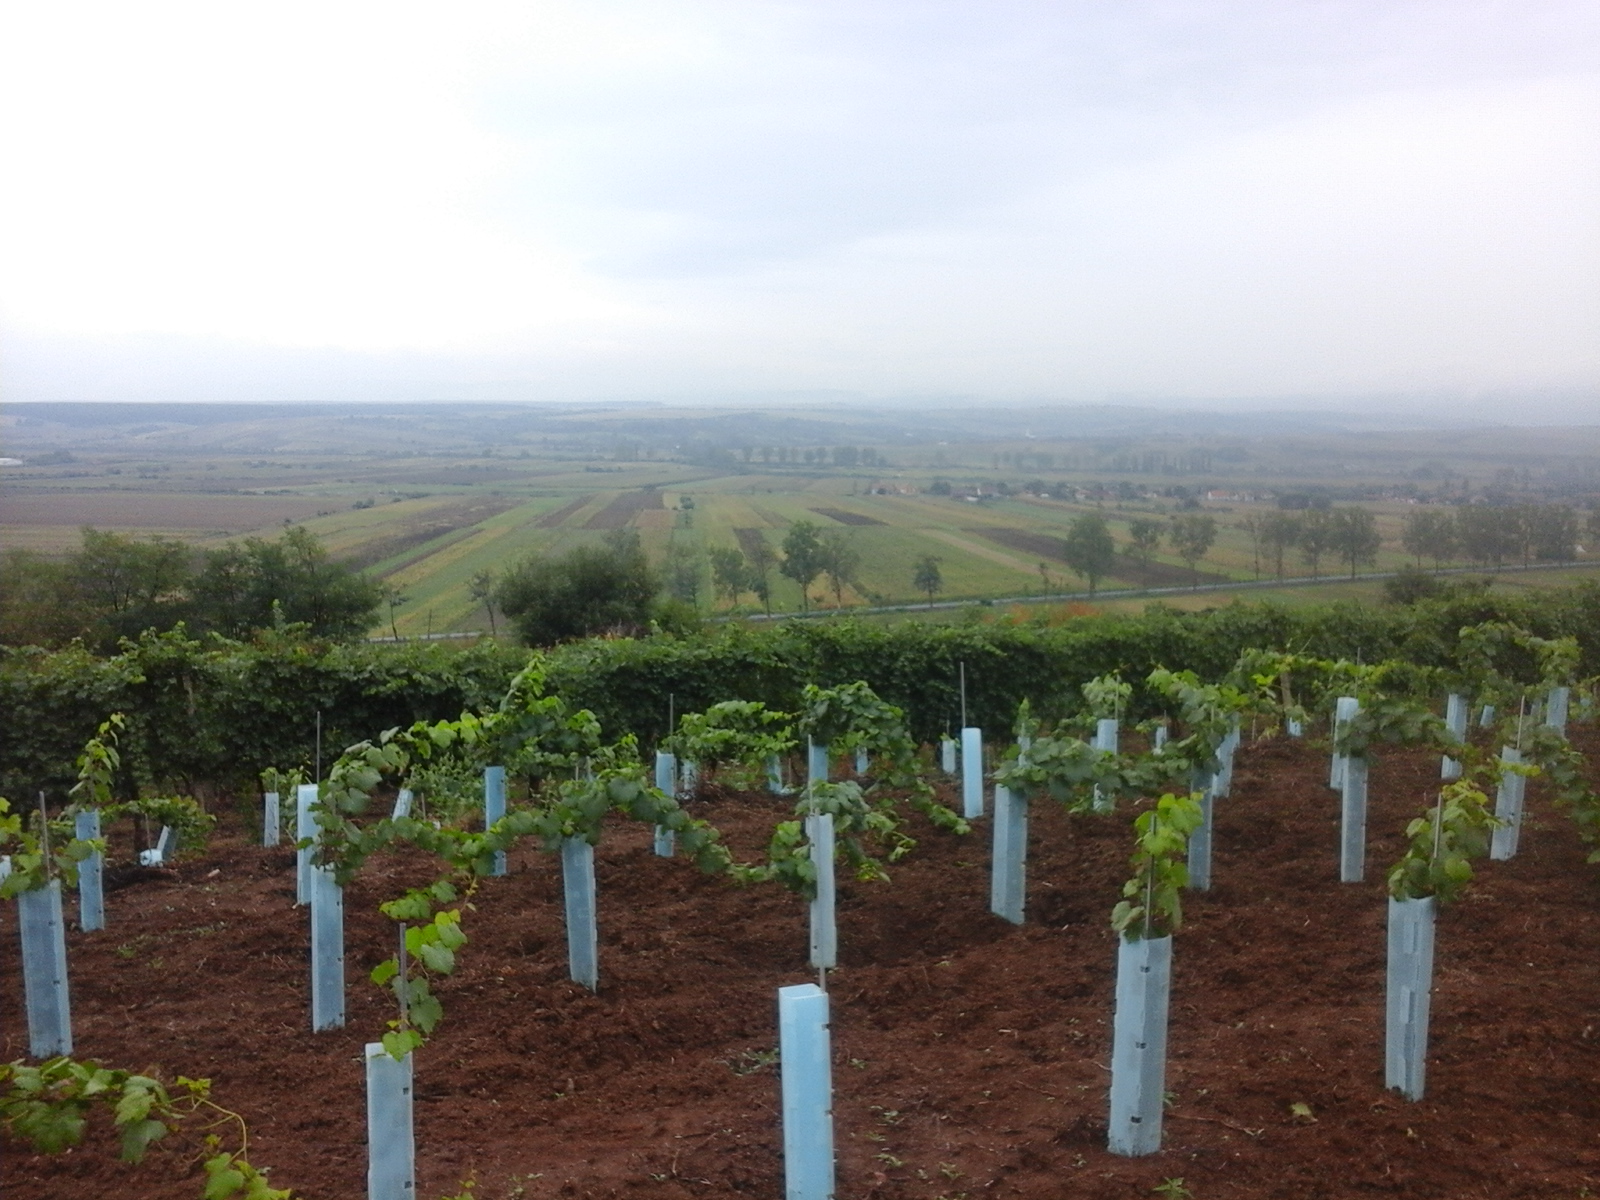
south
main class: Cropland
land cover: Vineyards
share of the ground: > 75 %
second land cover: Other bare soil
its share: > 75 %
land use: Agriculture (excluding fallow land and kitchen gardens)
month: September
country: RO
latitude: 47.2398
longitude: 22.6204
